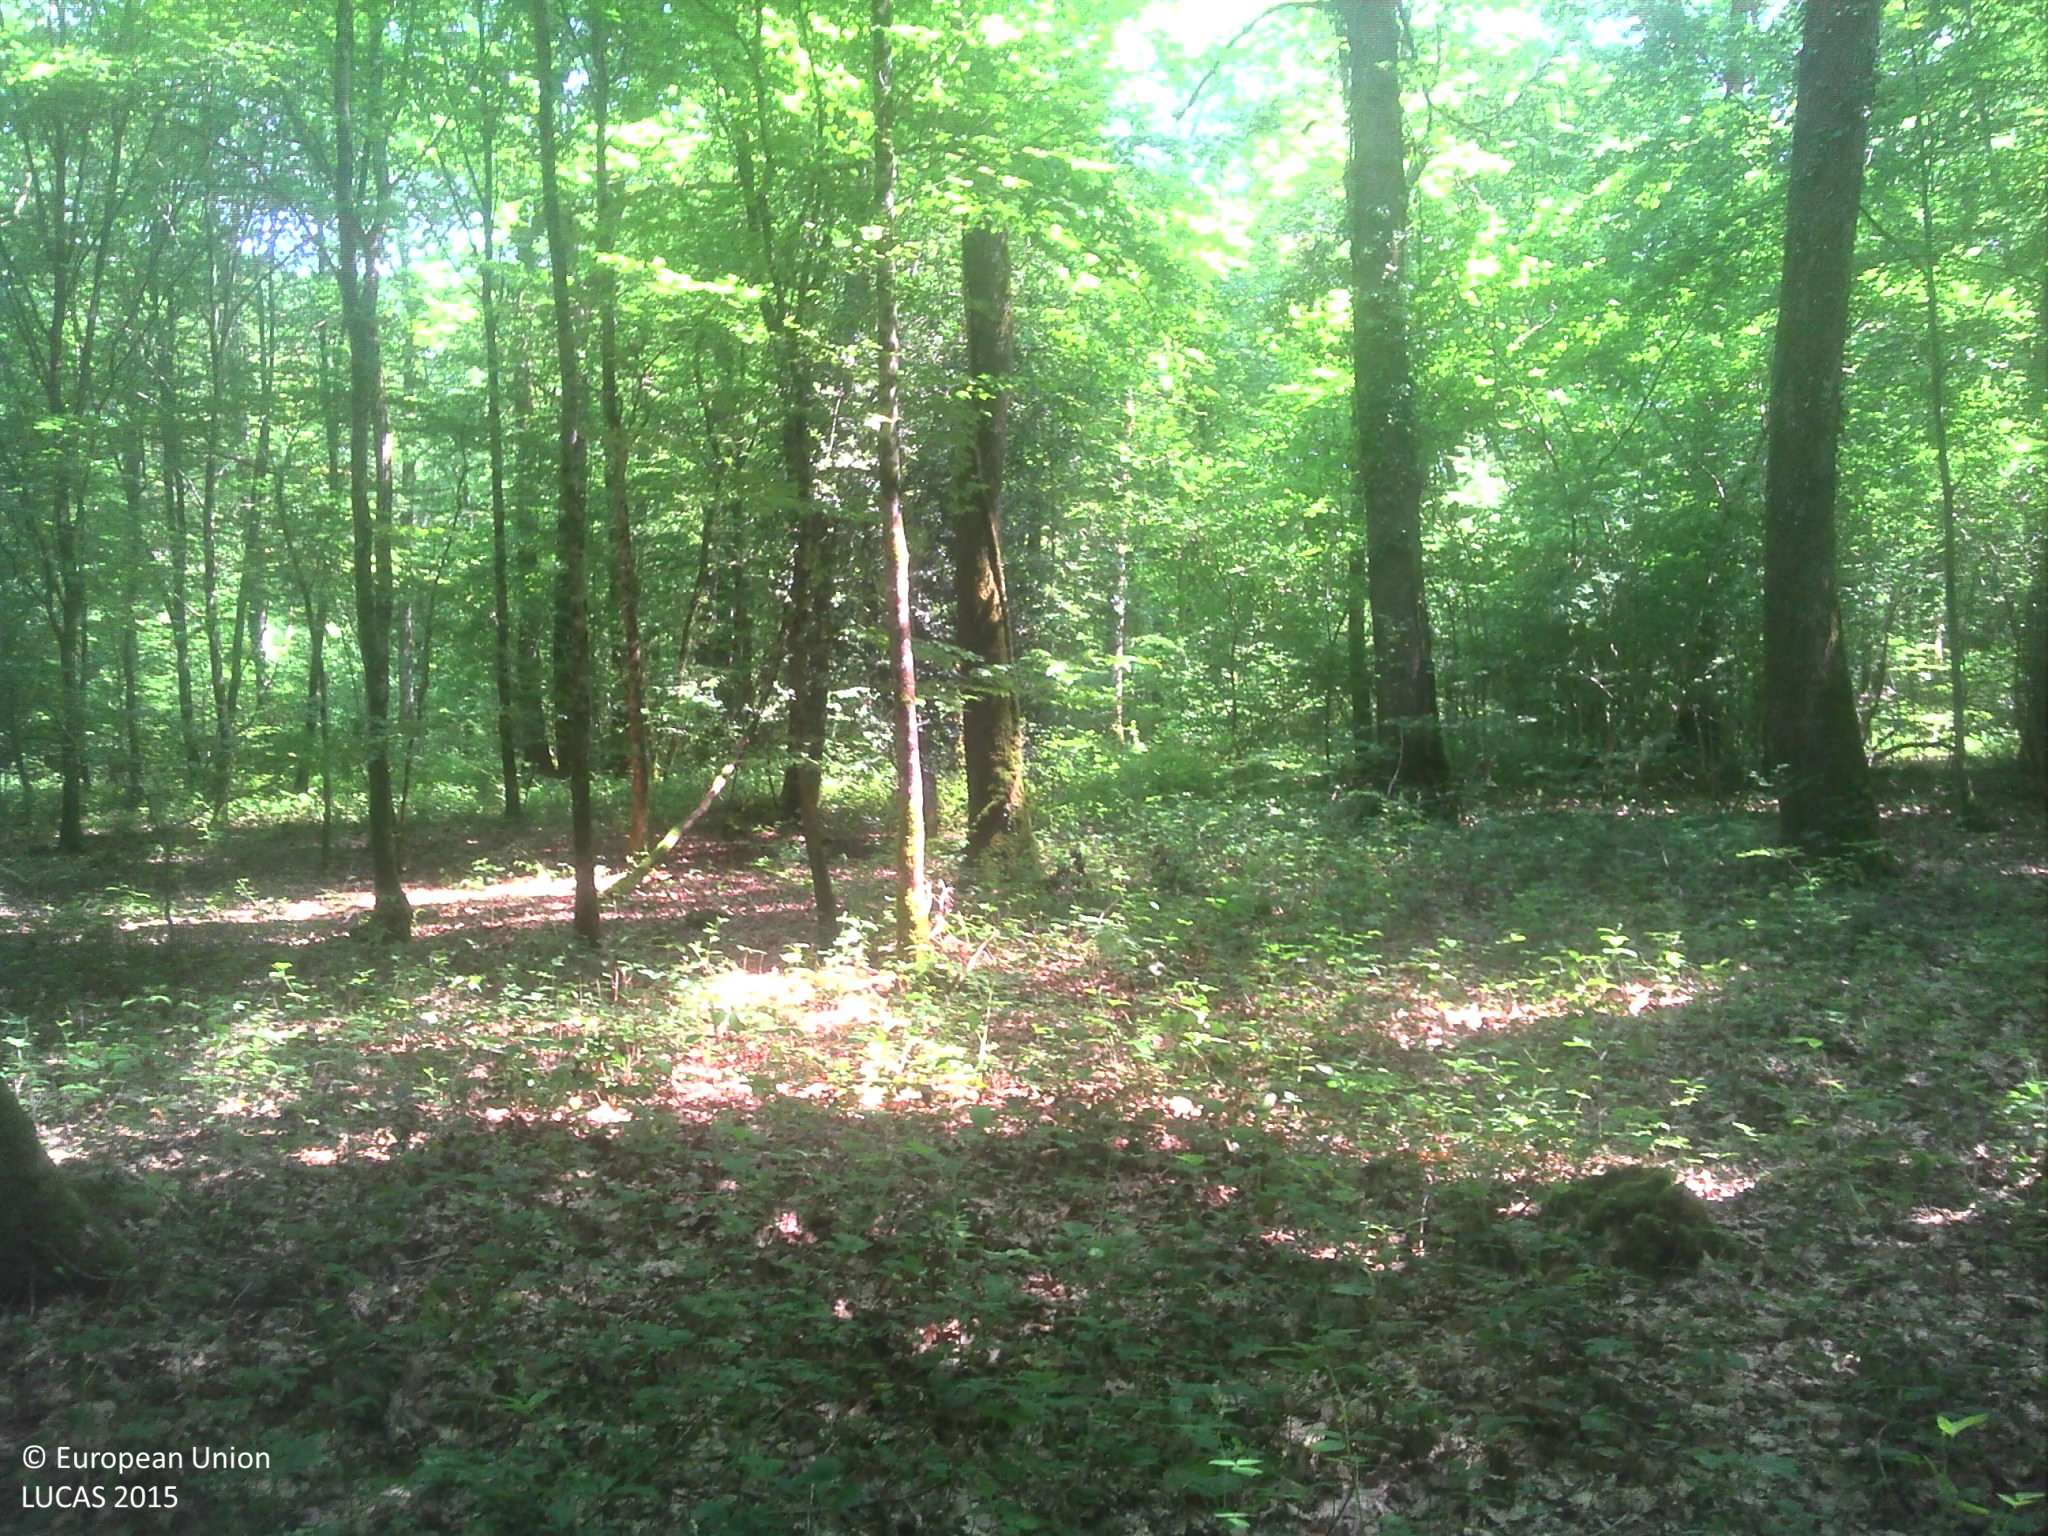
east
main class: Woodland
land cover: Broadleaved woodland
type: beech forest
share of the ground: > 75 %
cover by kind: broadleaved forest trees 90 %, herbaceous plants 10 %
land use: Forestry
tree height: > 5 m
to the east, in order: Broadleaved woodland; Tracks; Broadleaved woodland; Tracks; Broadleaved woodland
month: June
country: FR
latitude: 48.4649
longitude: 4.8724
